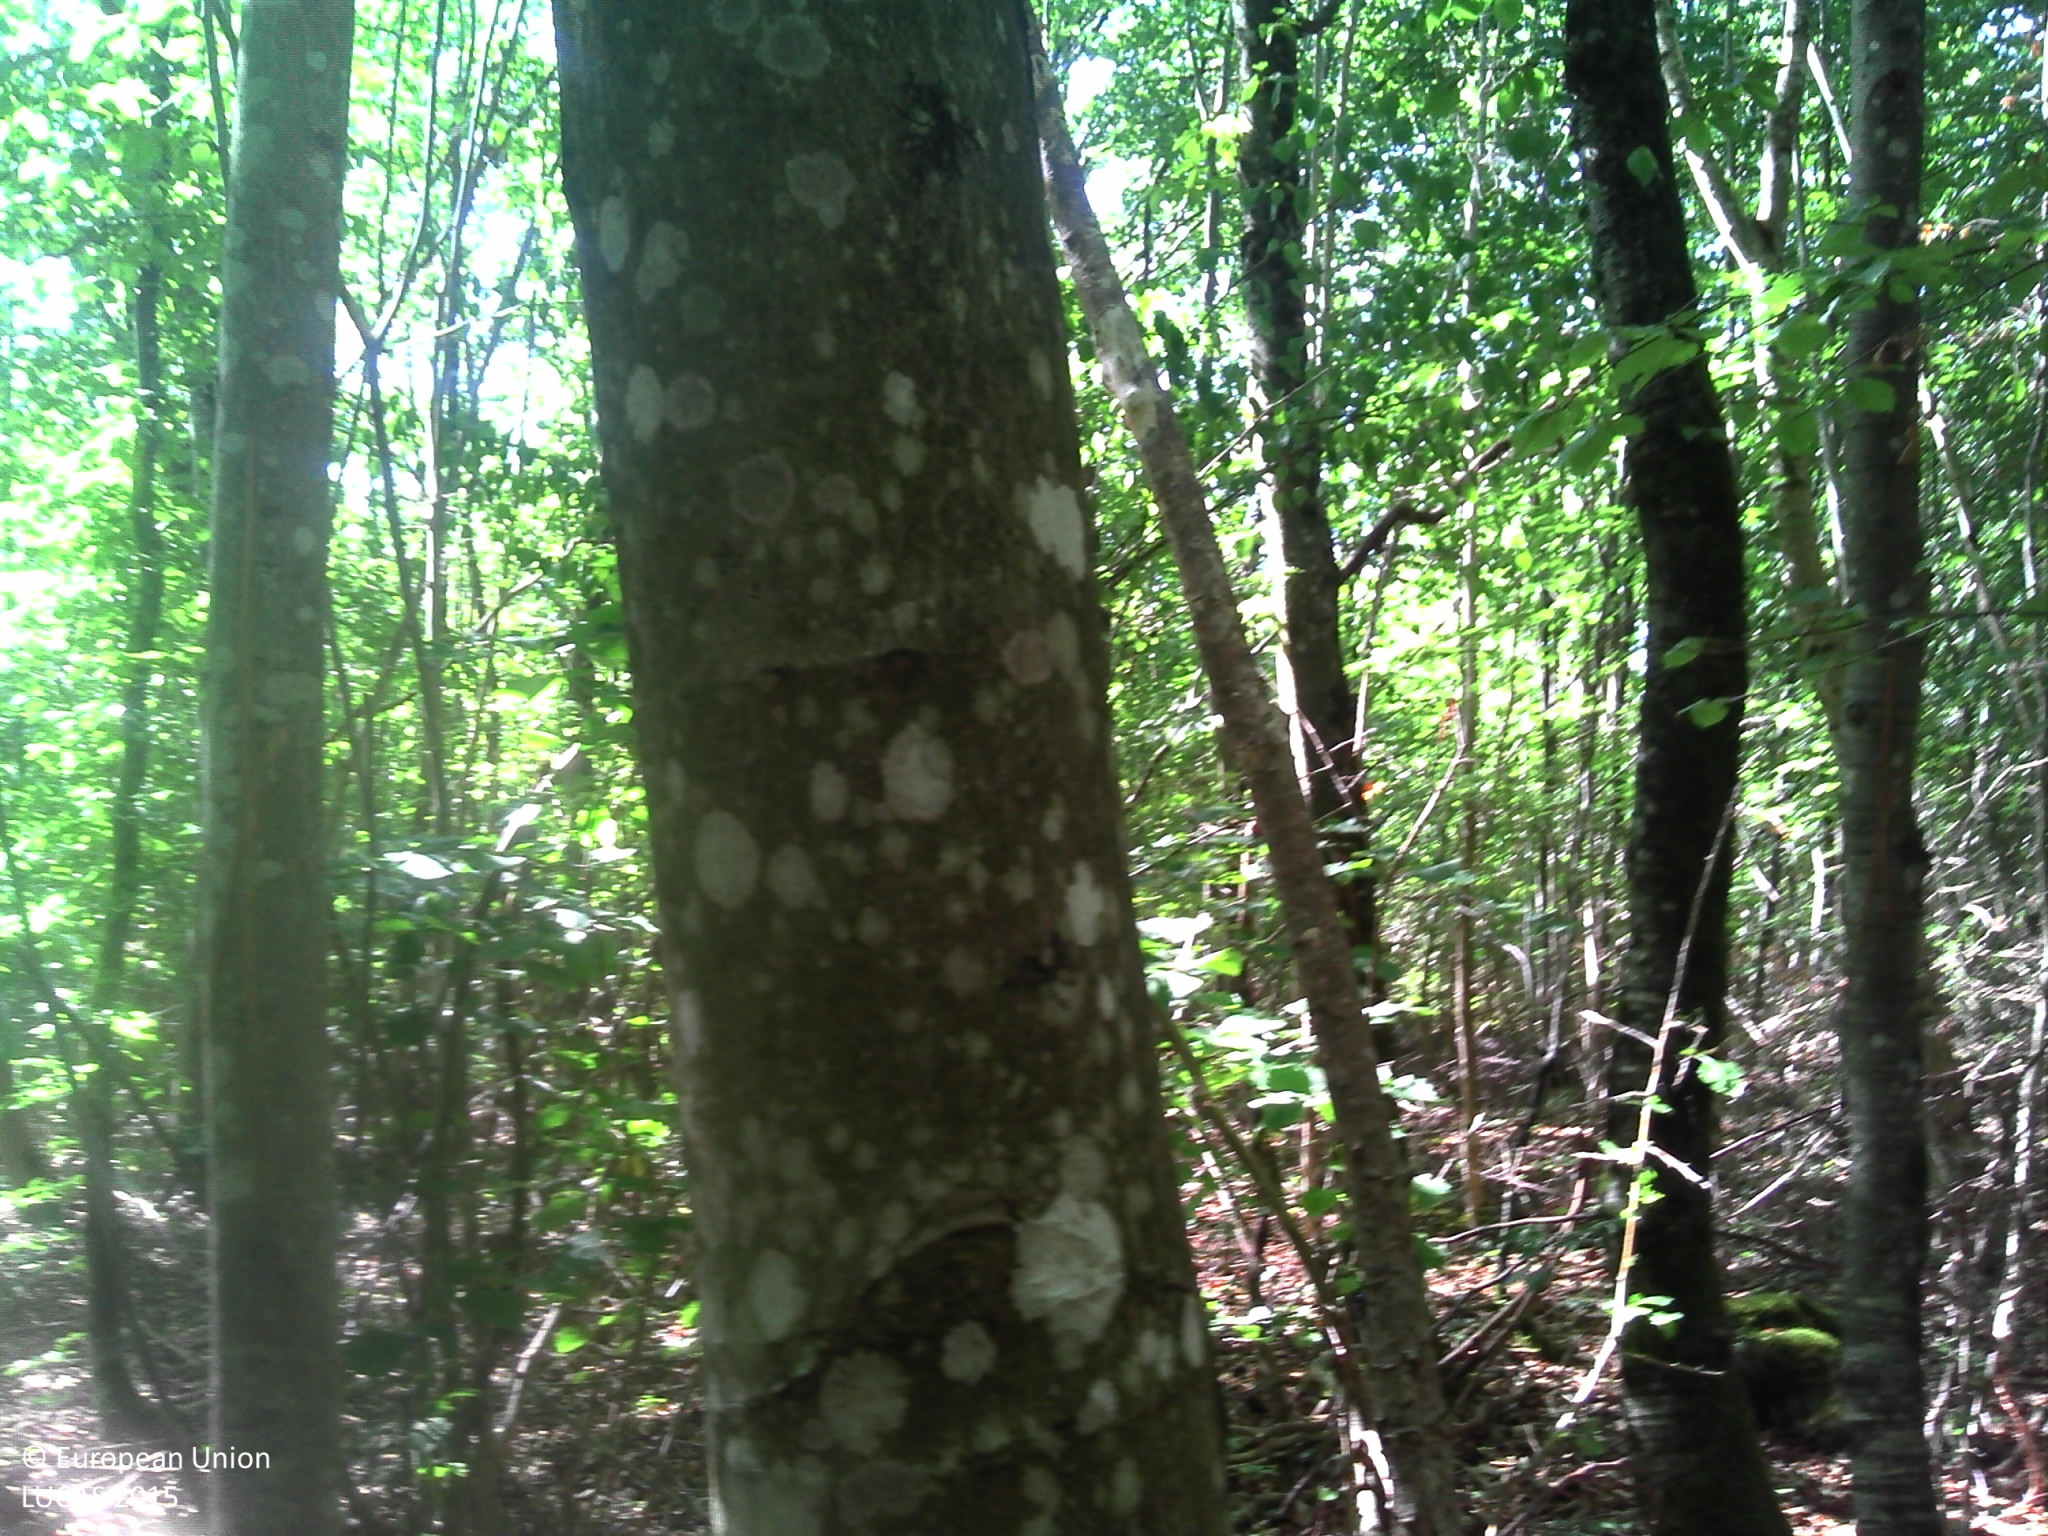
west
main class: Woodland
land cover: Broadleaved woodland
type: beech forest
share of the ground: > 75 %
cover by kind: broadleaved forest trees 90 %, herbaceous plants 5 %, lichens and mosses 5 %
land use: Forestry
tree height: > 5 m
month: August
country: FR
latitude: 47.7734
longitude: 5.1291
